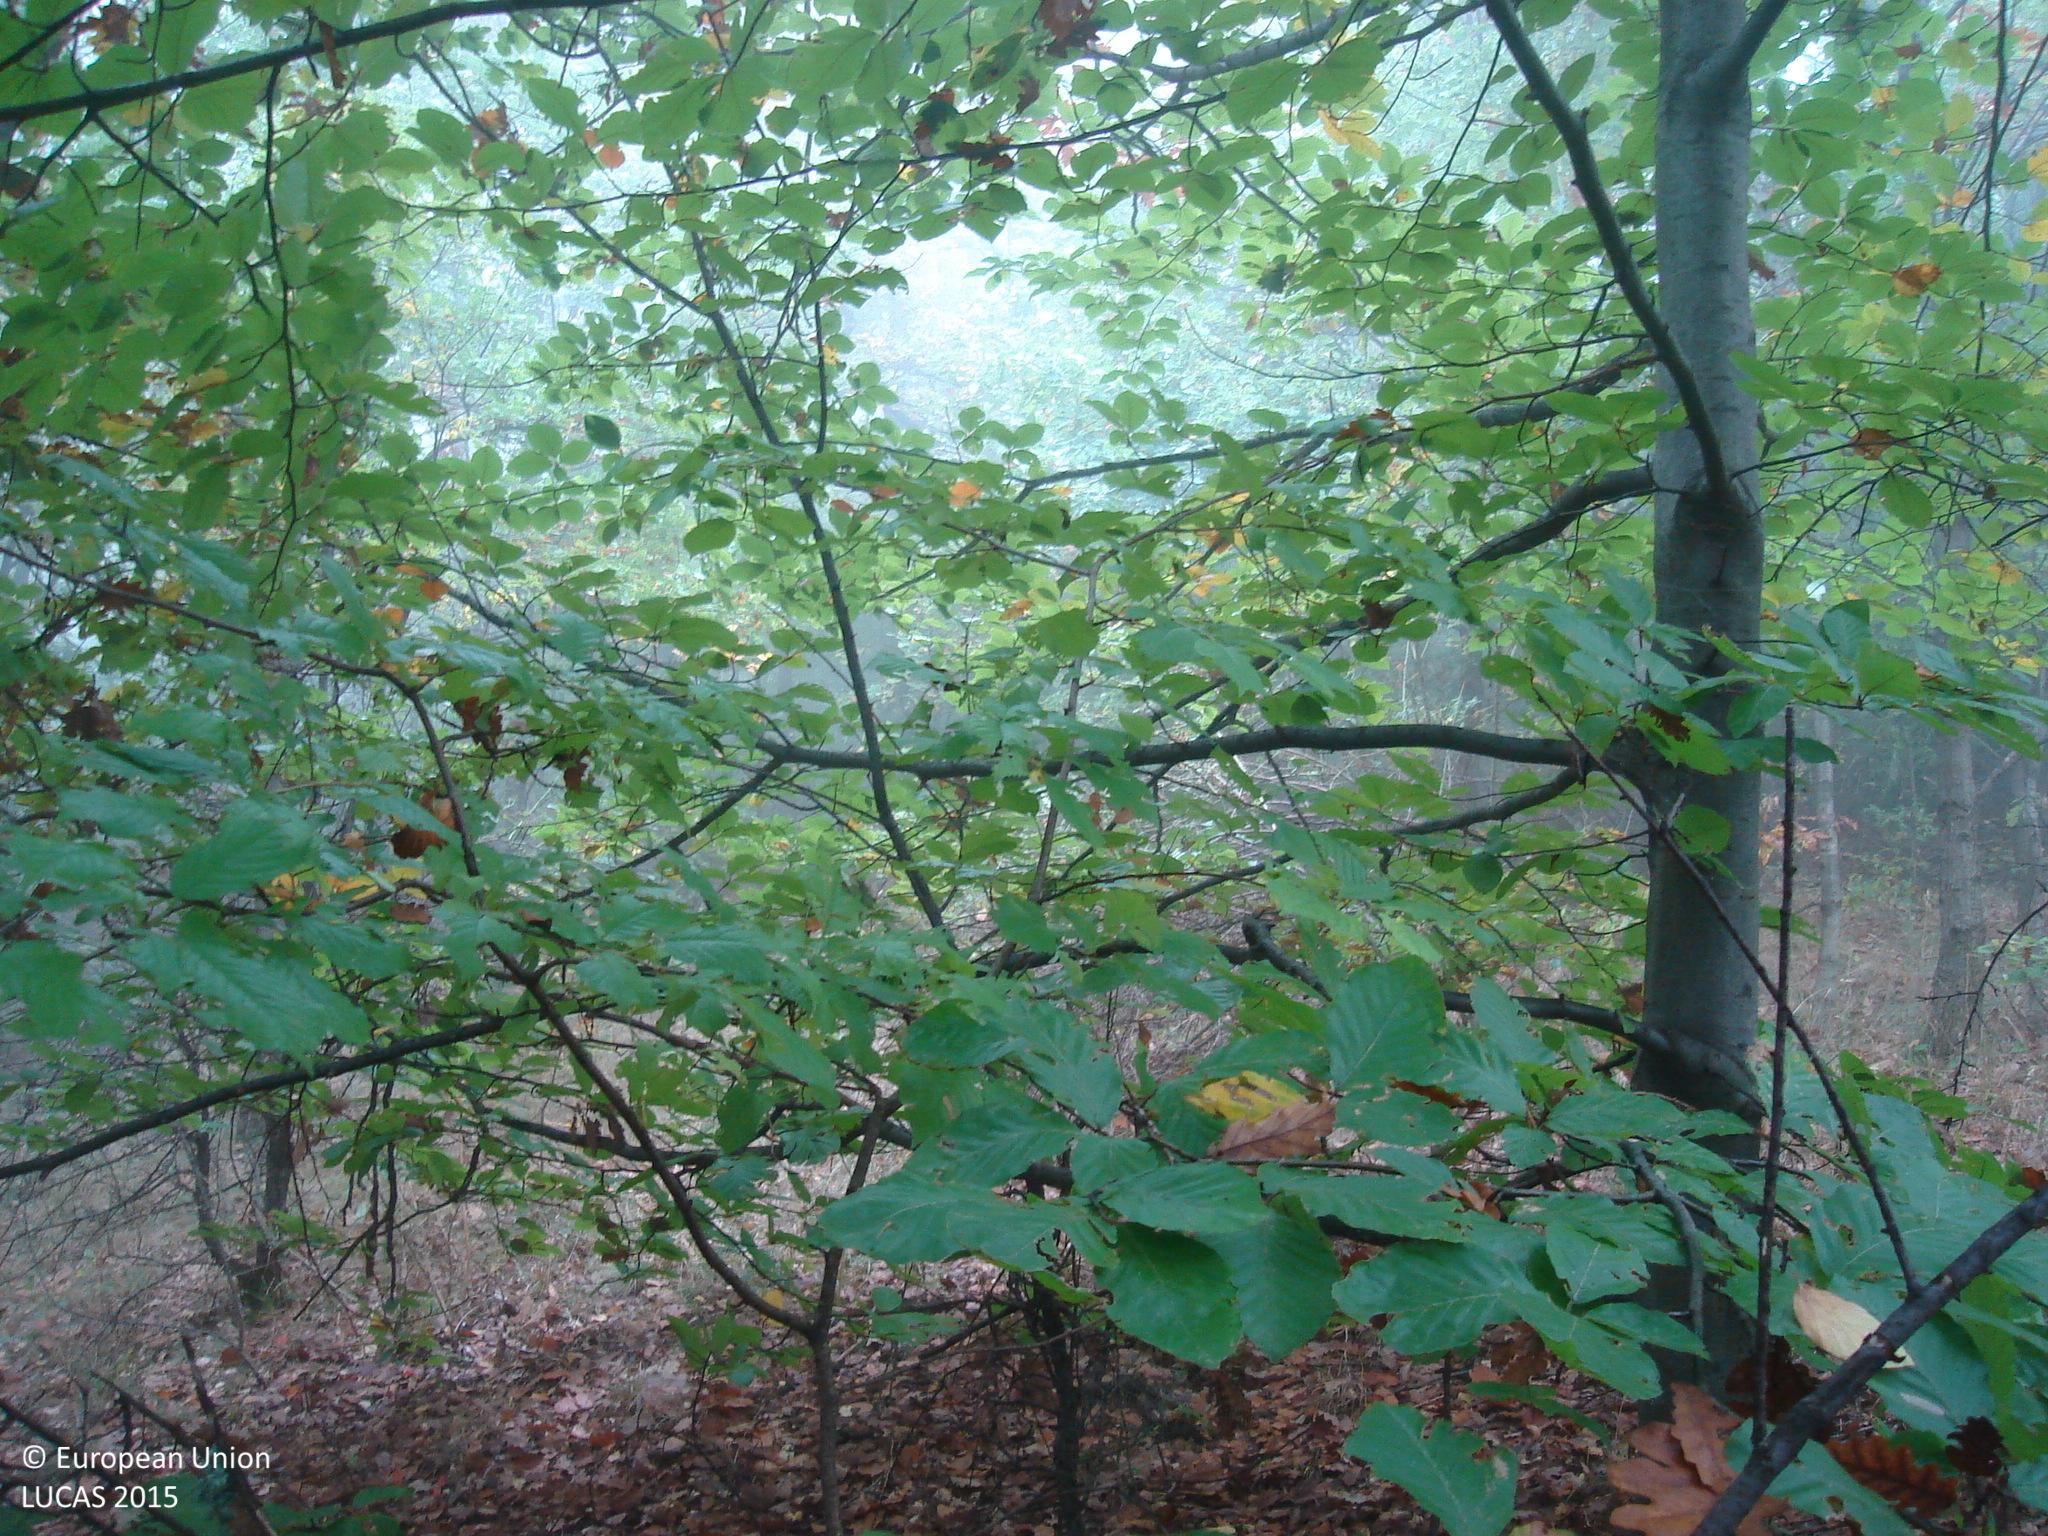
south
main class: Woodland
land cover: Broadleaved woodland
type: mesophytic deciduous forest
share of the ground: > 75 %
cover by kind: broadleaved forest trees 80 %, unconsolidated bare surface 20 %
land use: Forestry
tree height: > 5 m
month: October
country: BG
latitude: 42.4777
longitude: 23.8957
